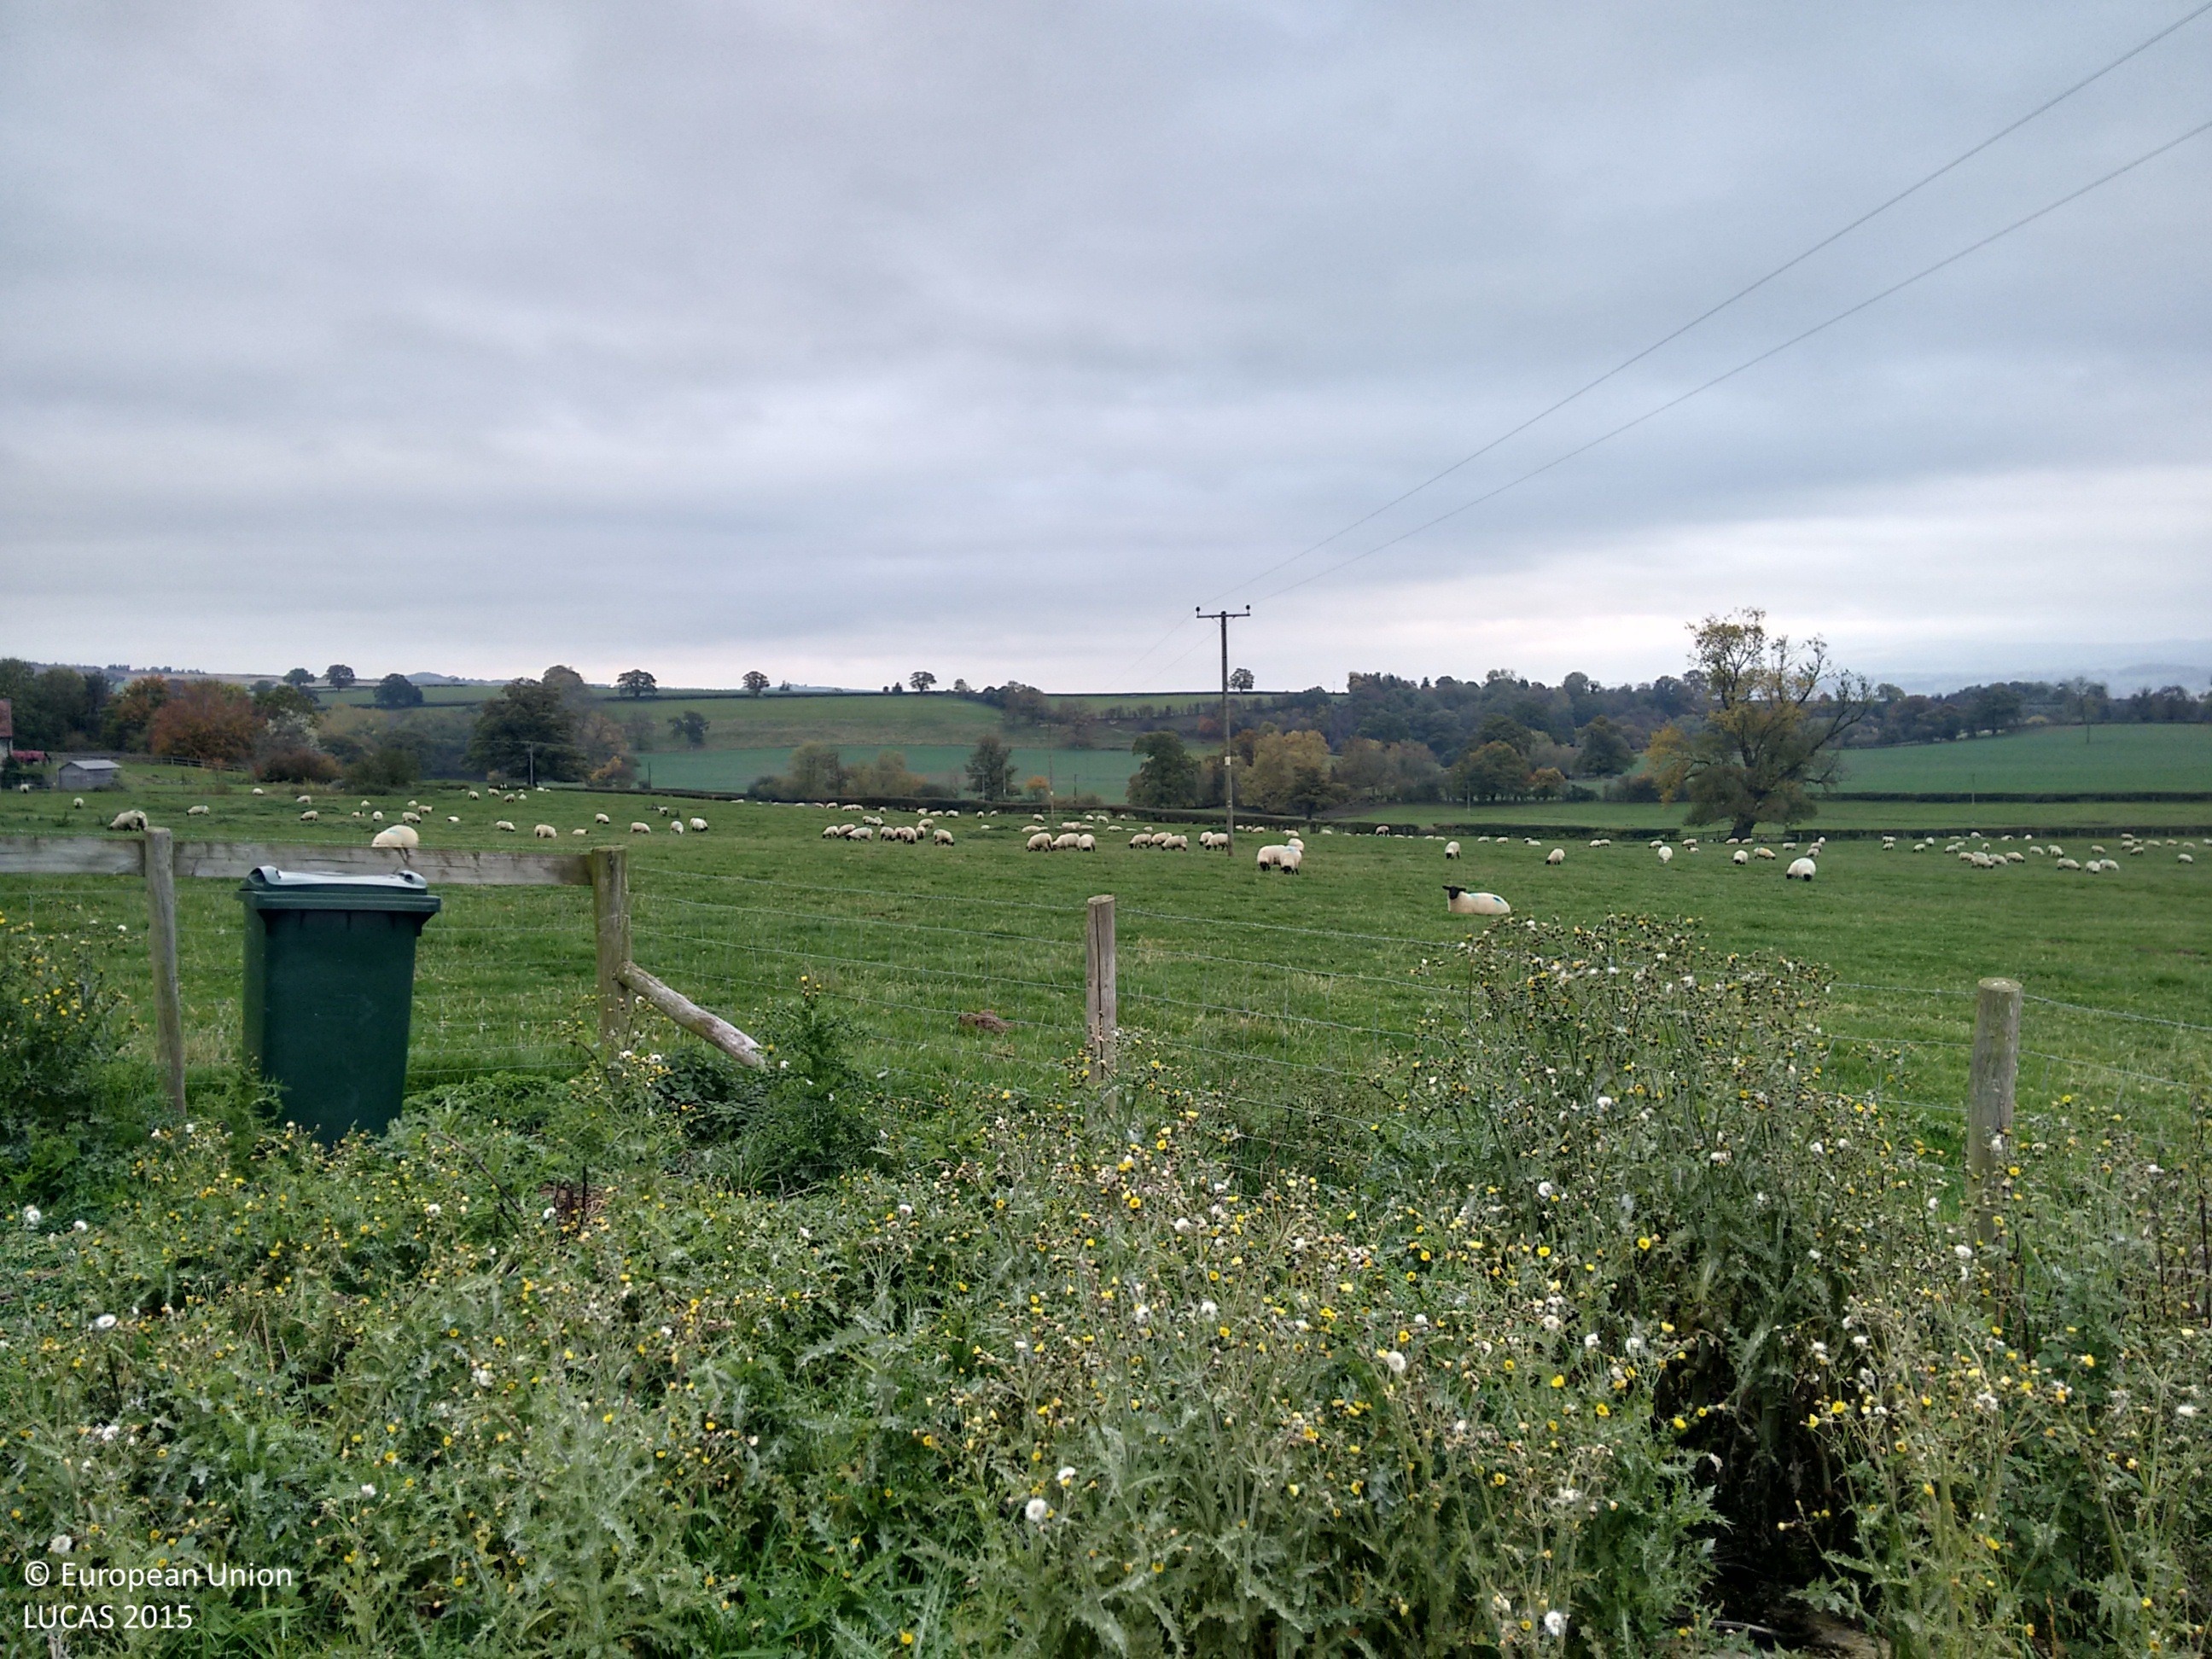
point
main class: Grassland
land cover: Grassland without tree/shrub cover
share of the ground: > 75 %
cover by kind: herbaceous plants 100 %
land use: Agriculture (excluding fallow land and kitchen gardens)
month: October
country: GB
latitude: 52.4284
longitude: -2.7928
